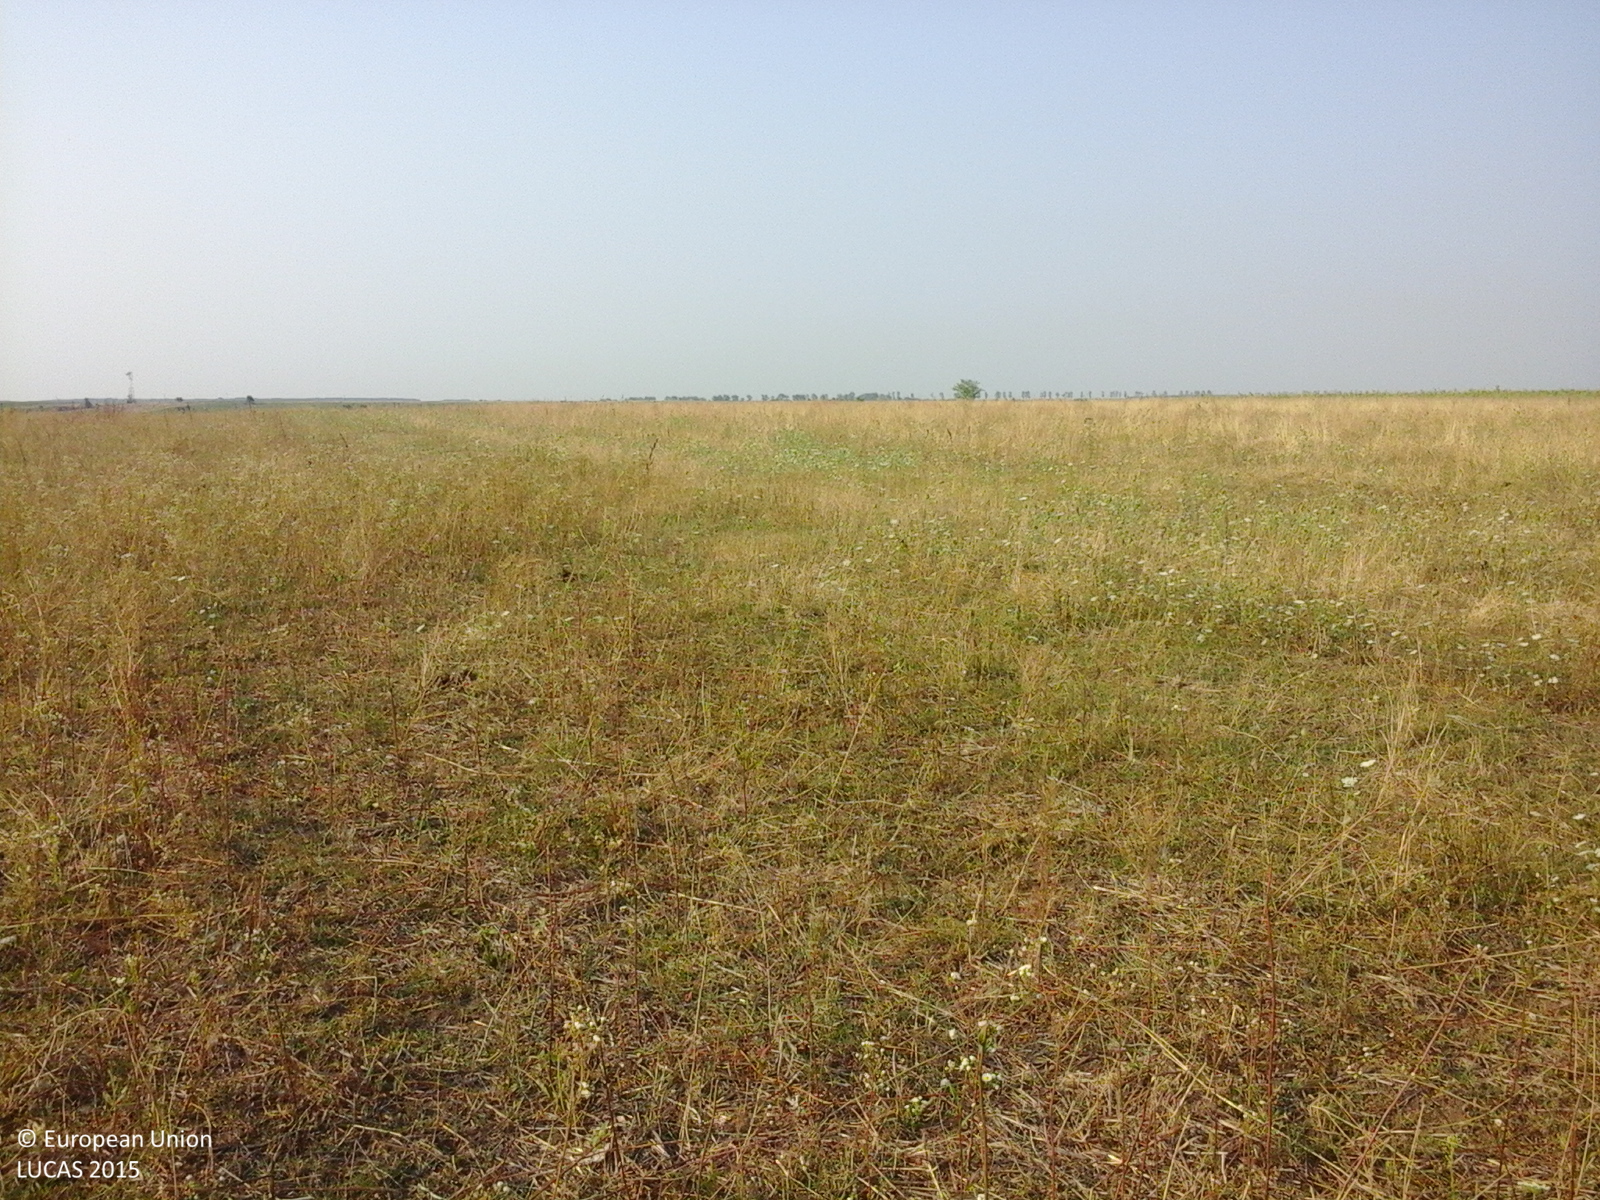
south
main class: Grassland
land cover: Grassland without tree/shrub cover
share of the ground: > 75 %
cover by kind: herbaceous plants 100 %
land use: Agriculture (excluding fallow land and kitchen gardens)
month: August
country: RO
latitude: 44.4775
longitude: 23.2882
